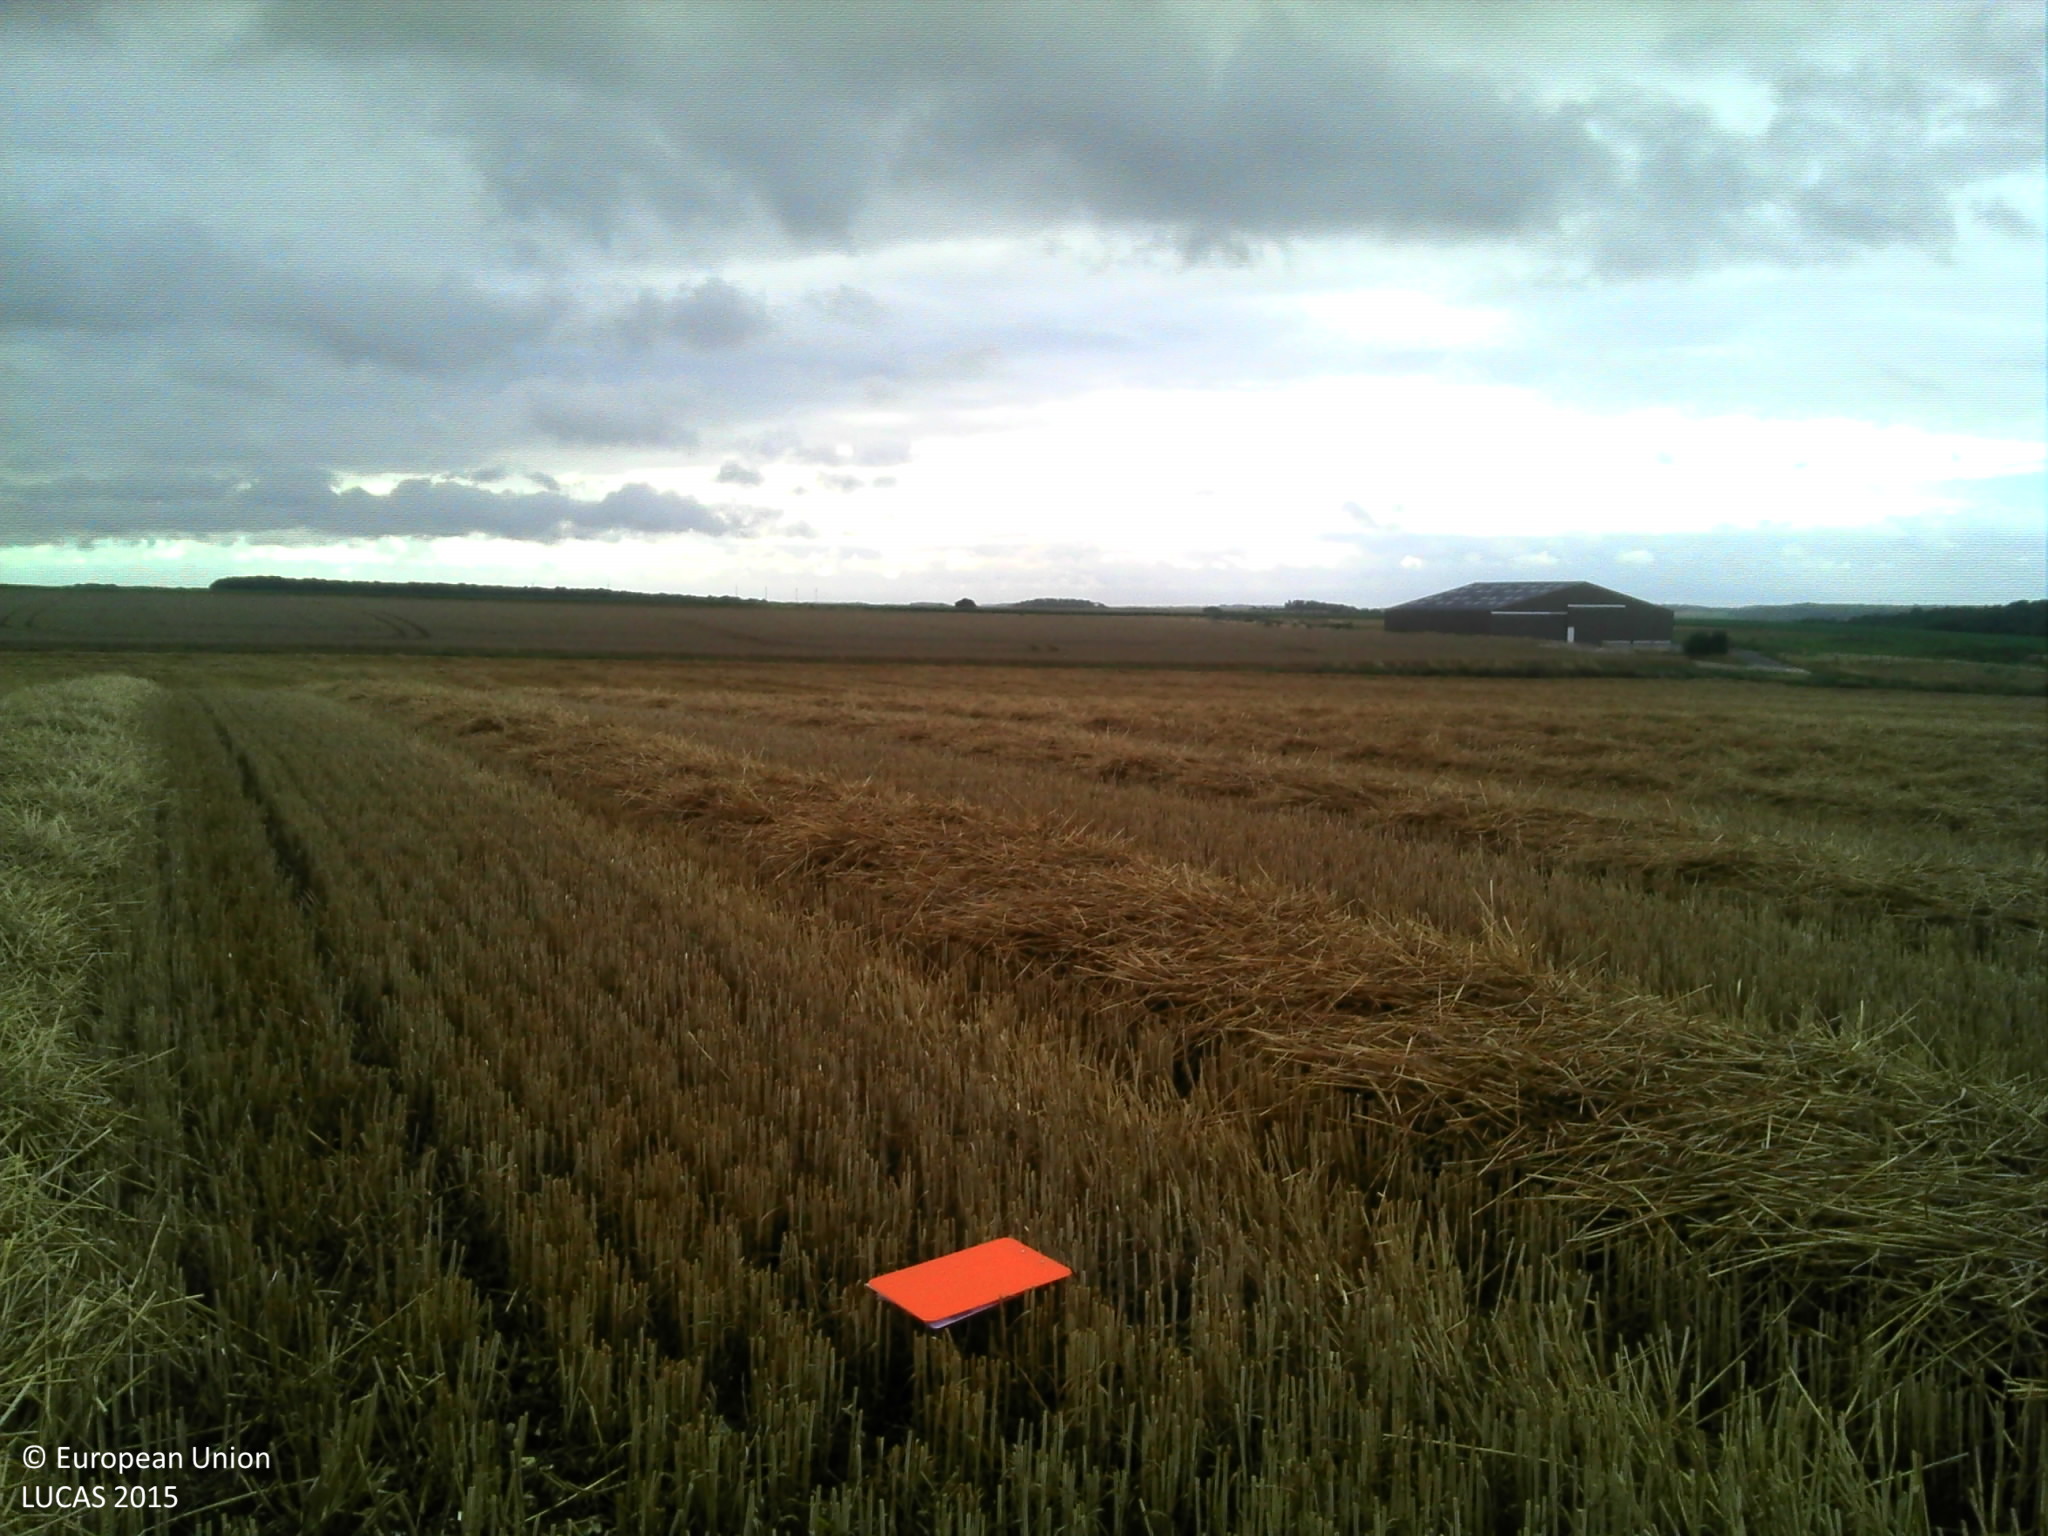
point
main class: Cropland
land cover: Common wheat
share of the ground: > 75 %
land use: Agriculture (excluding fallow land and kitchen gardens)
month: July
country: FR
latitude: 49.8444
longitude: 2.4643
